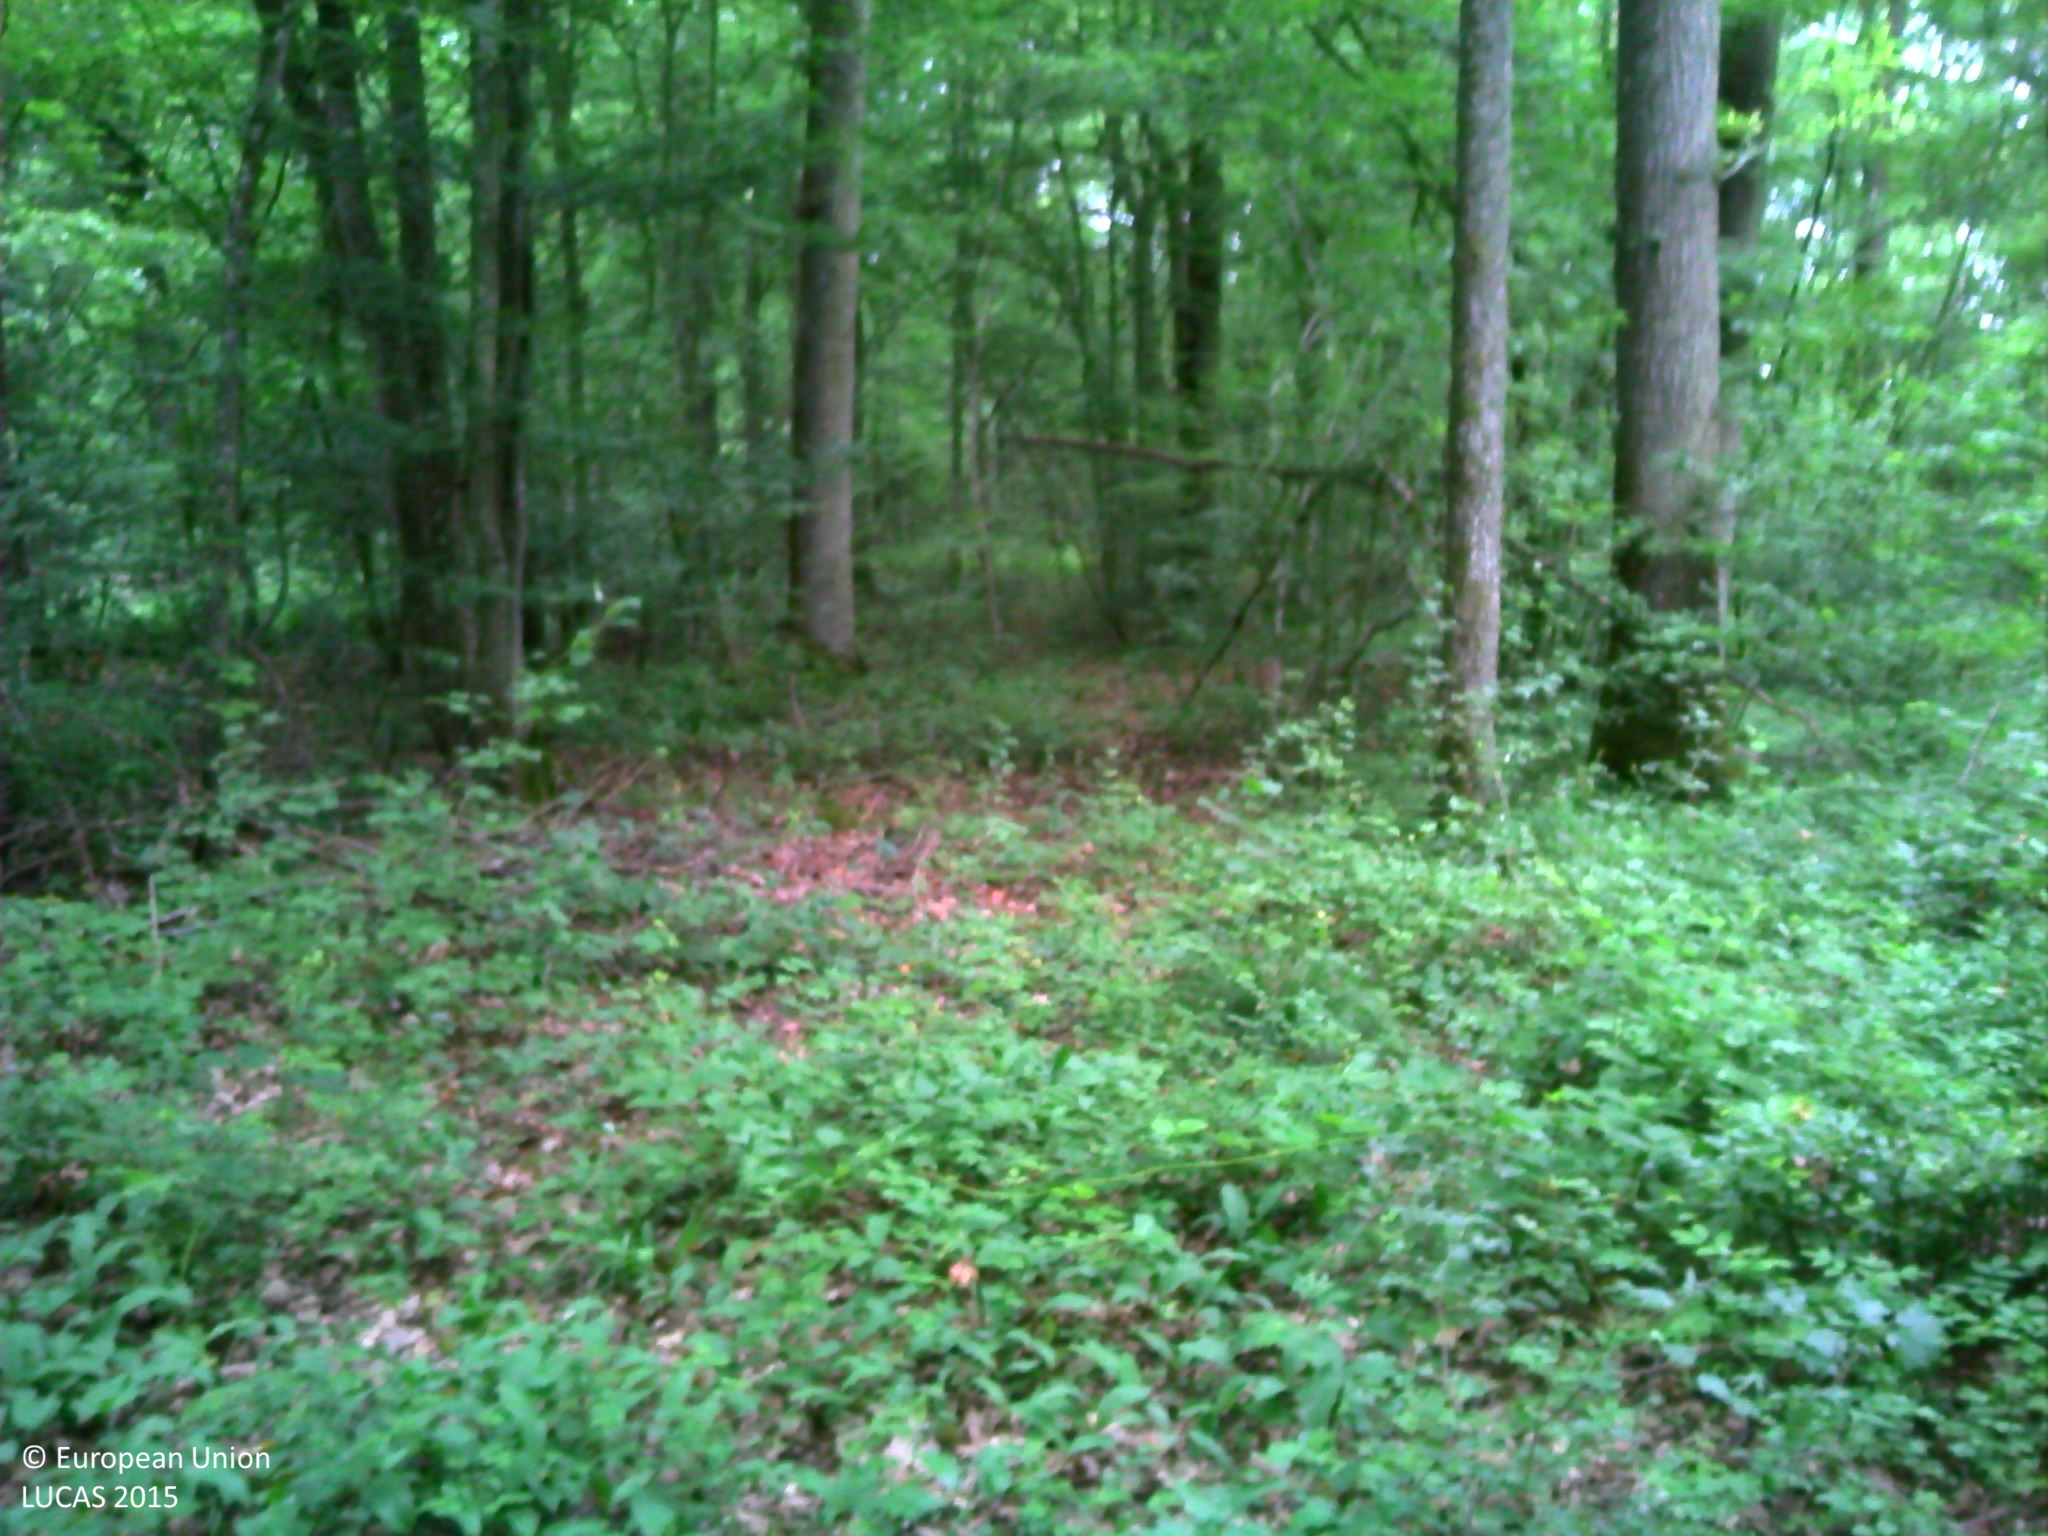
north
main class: Woodland
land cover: Broadleaved woodland
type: mesophytic deciduous forest
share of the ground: > 75 %
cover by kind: broadleaved forest trees 90 %, herbaceous plants 5 %, lichens and mosses 5 %
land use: Forestry
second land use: Amenities, museums, leisure
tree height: > 5 m
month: June
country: FR
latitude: 48.5937
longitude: 6.2987
